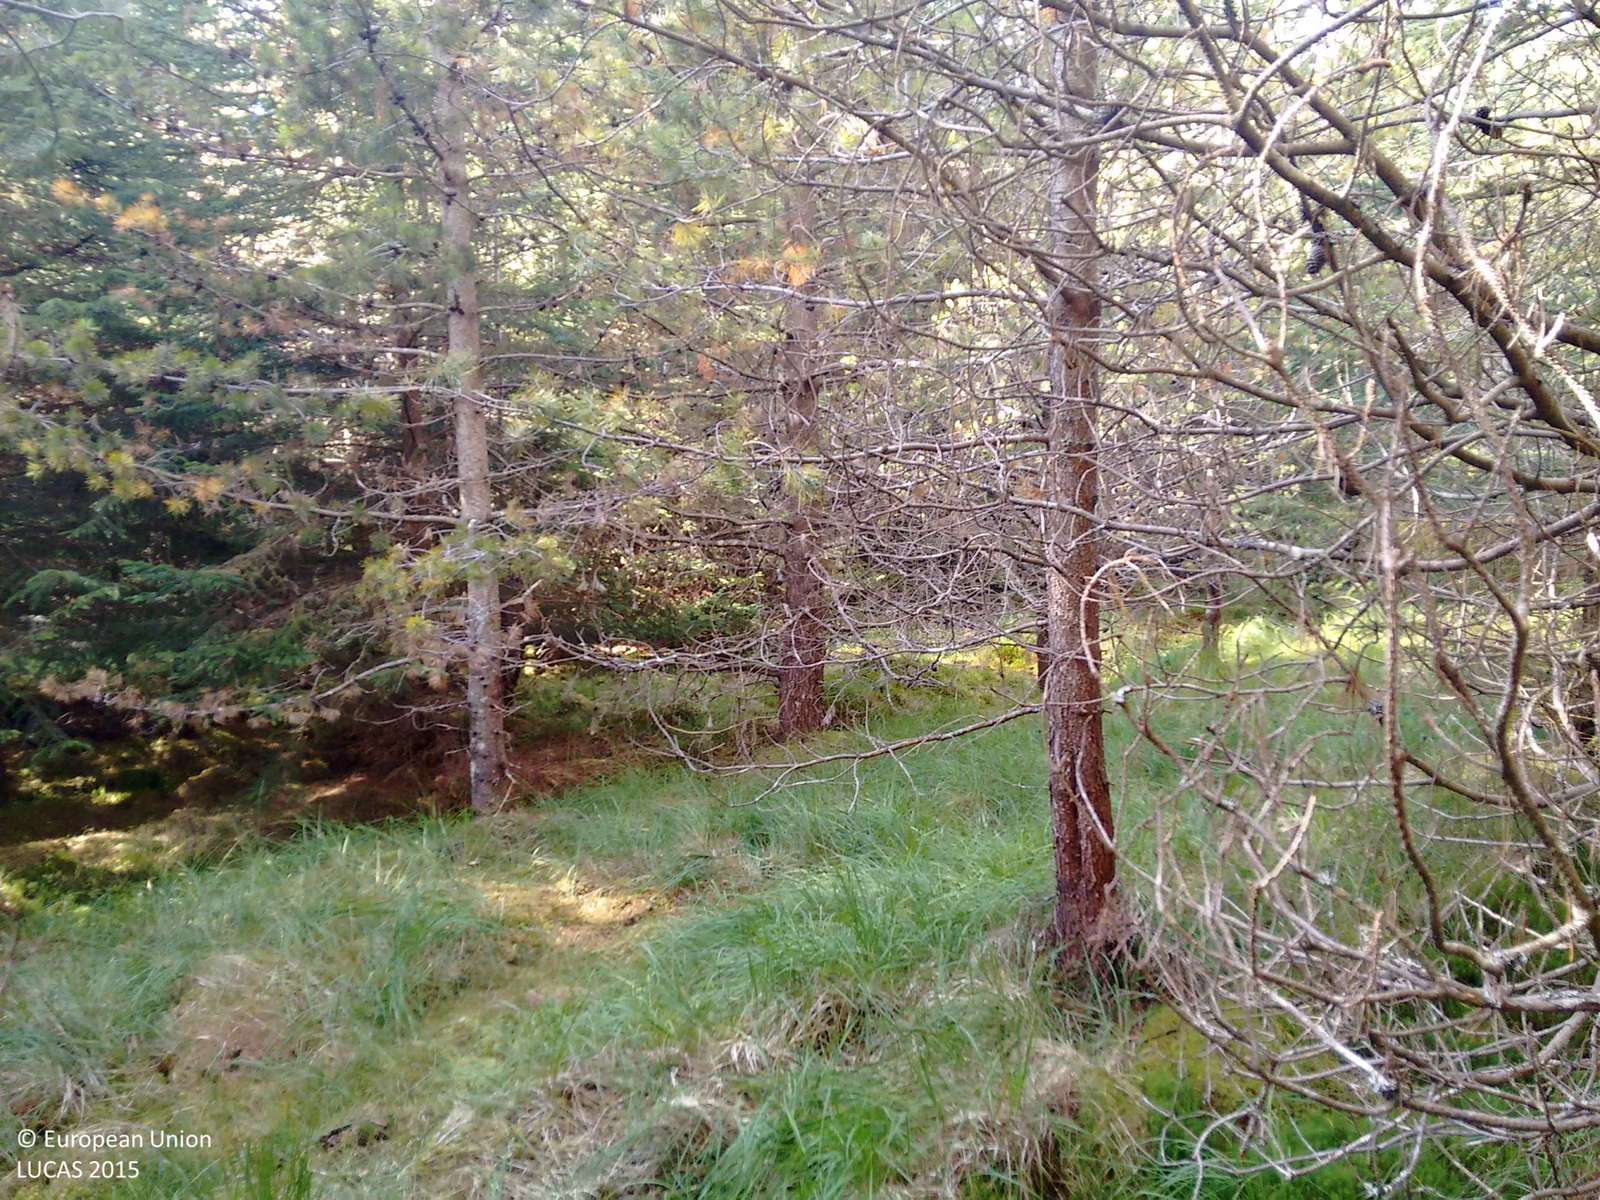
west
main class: Woodland
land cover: Spruce dominated coniferous woodland
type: exotic forest
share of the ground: > 75 %
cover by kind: coniferous forest trees 90 %, herbaceous plants 5 %, lichens and mosses 5 %
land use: Forestry
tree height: > 5 m
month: September
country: GB
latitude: 57.9712
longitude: -4.7167
